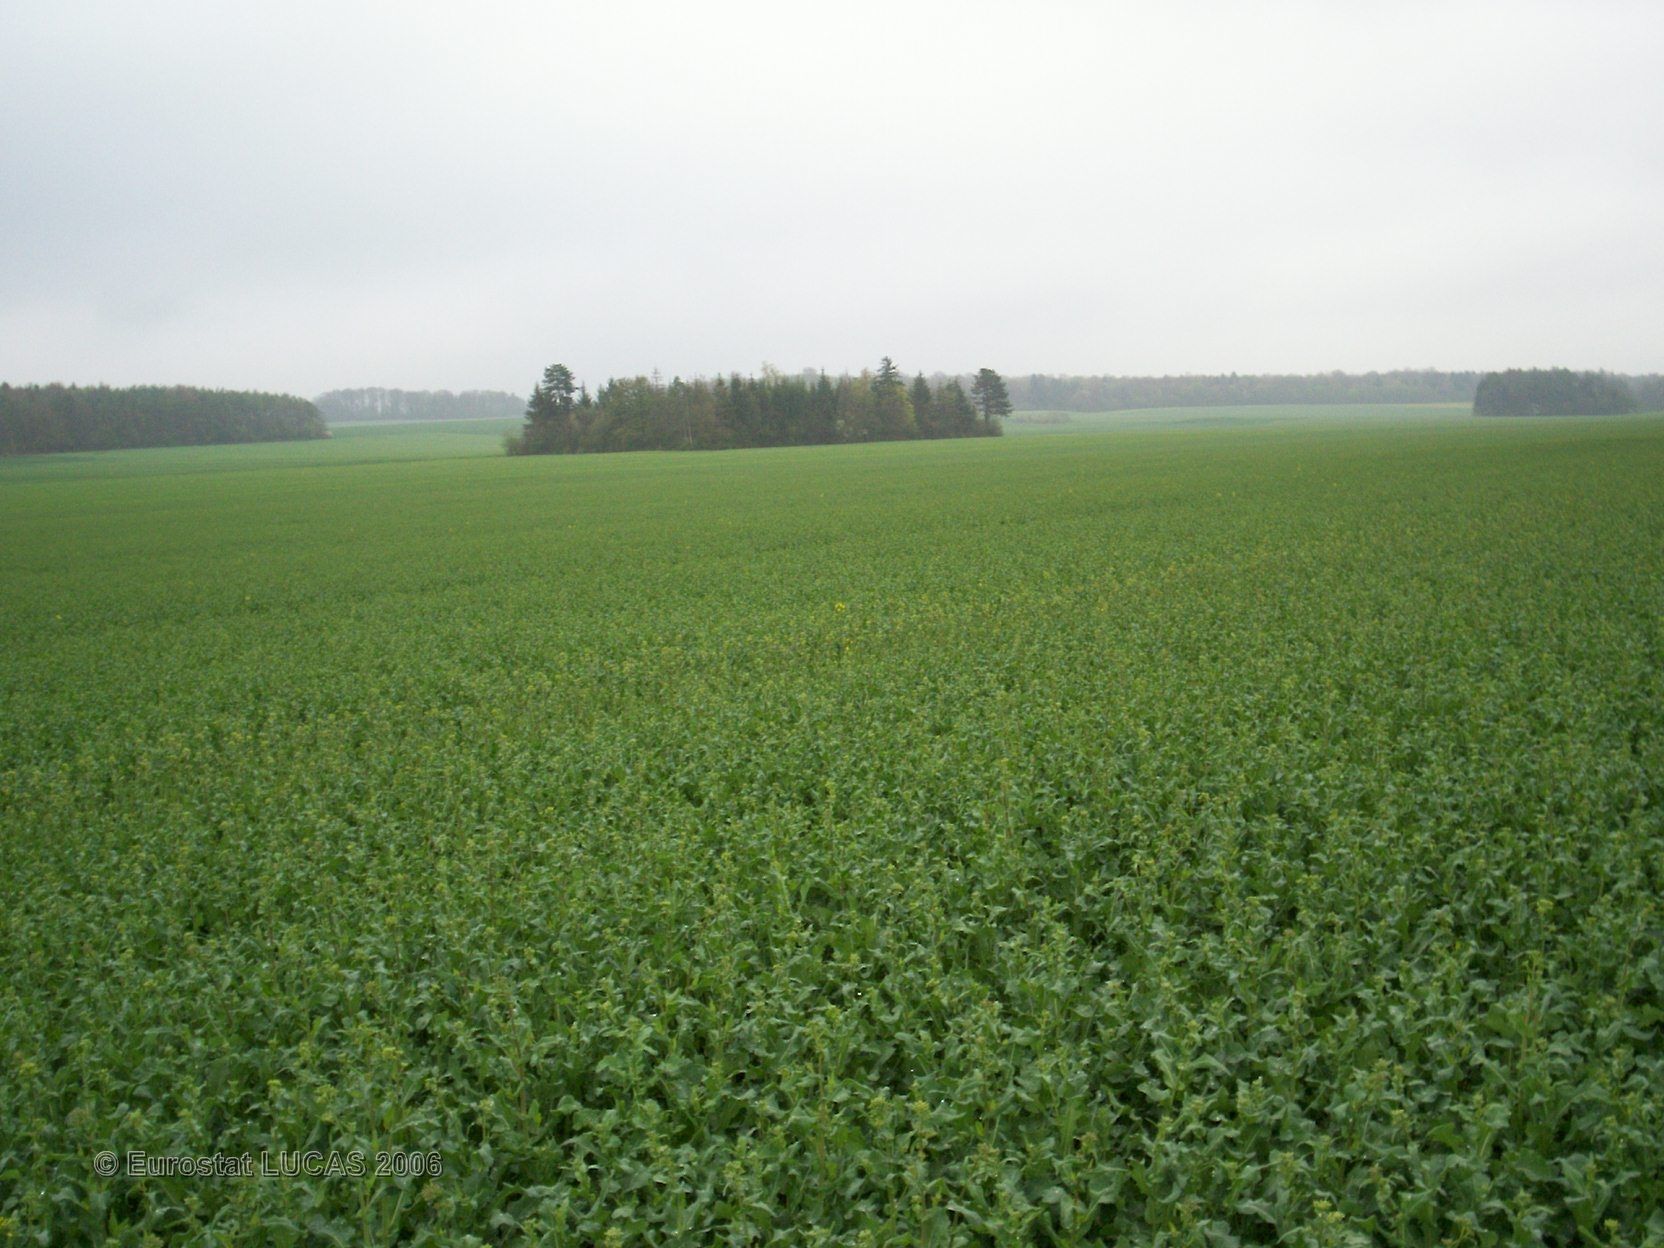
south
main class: Cropland
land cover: Rape and turnip rape
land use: Agriculture (excluding fallow land and kitchen gardens)
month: April
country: FR
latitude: 47.7983
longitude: 4.5113
